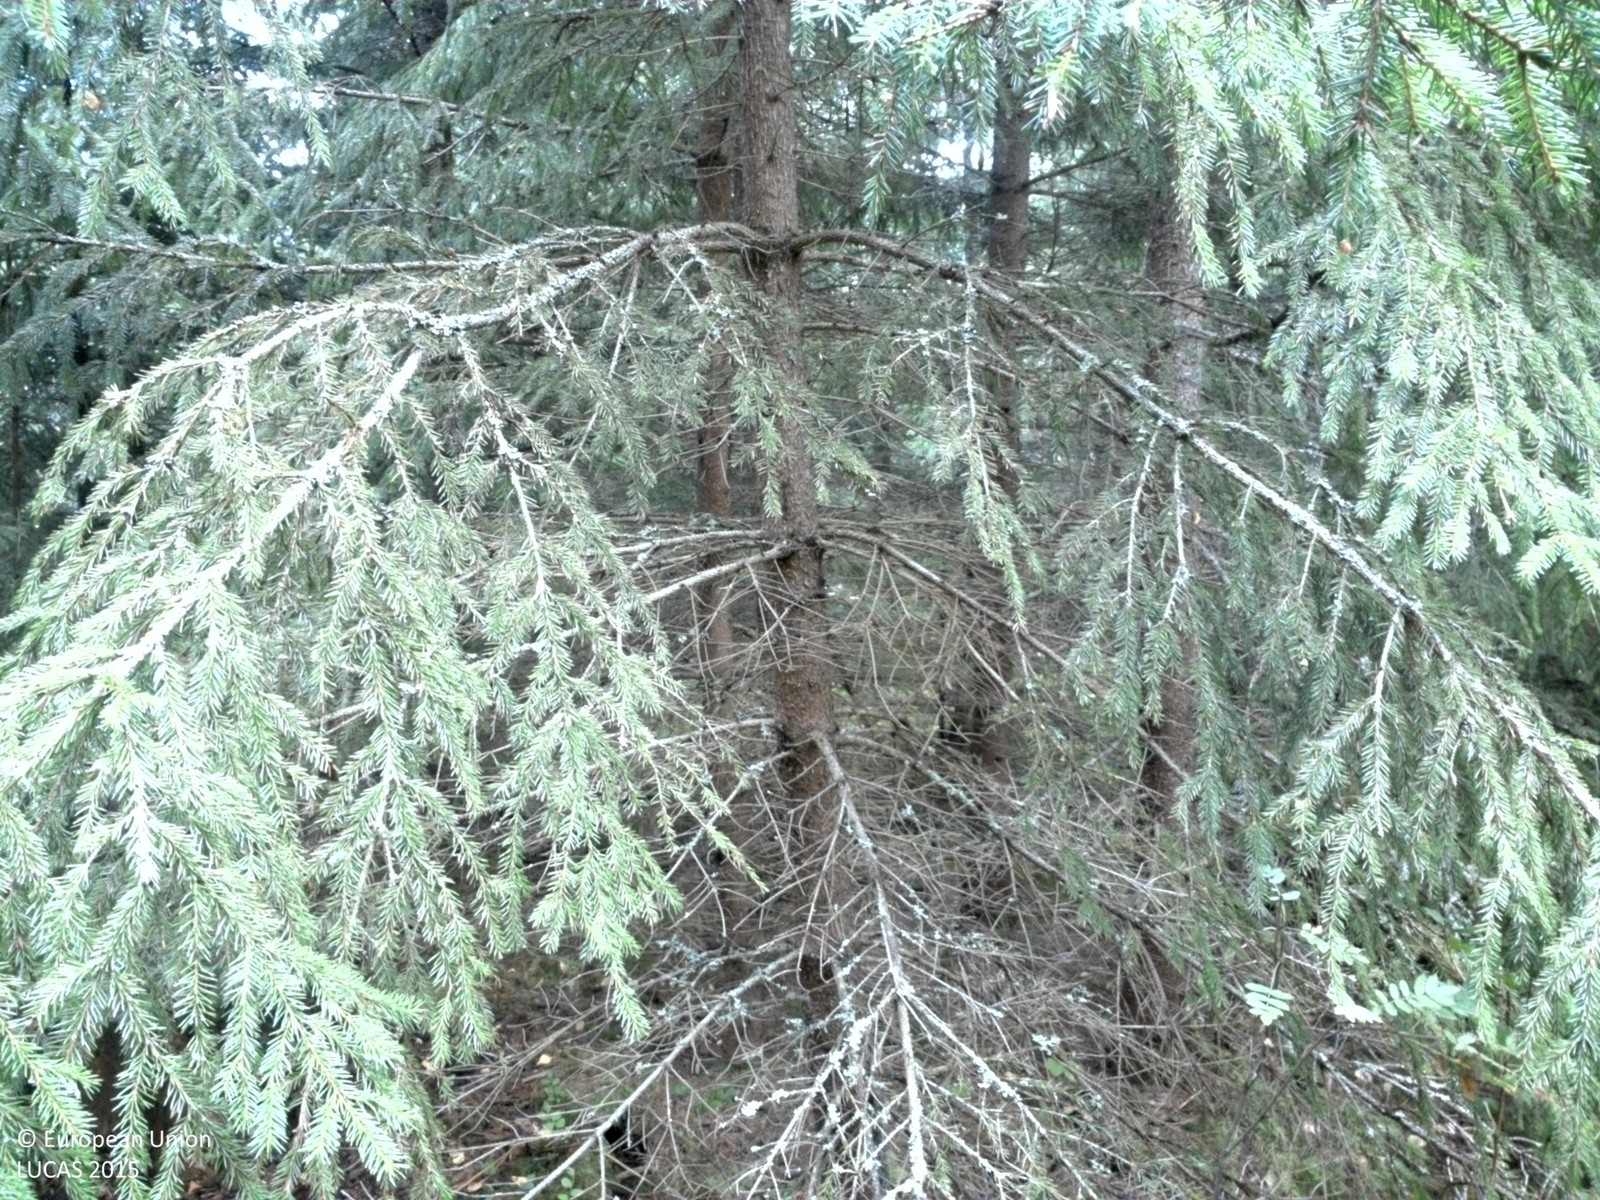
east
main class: Woodland
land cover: Spruce dominated coniferous woodland
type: boreal forest
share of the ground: > 75 %
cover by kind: coniferous forest trees 75 %, lichens and mosses 20 %, broadleaved forest trees 5 %
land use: Forestry
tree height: > 5 m
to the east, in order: Spruce dominated coniferous woodland; Other bare soil; Broadleaved woodland
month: August
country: SE
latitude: 59.9892
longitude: 17.6835
